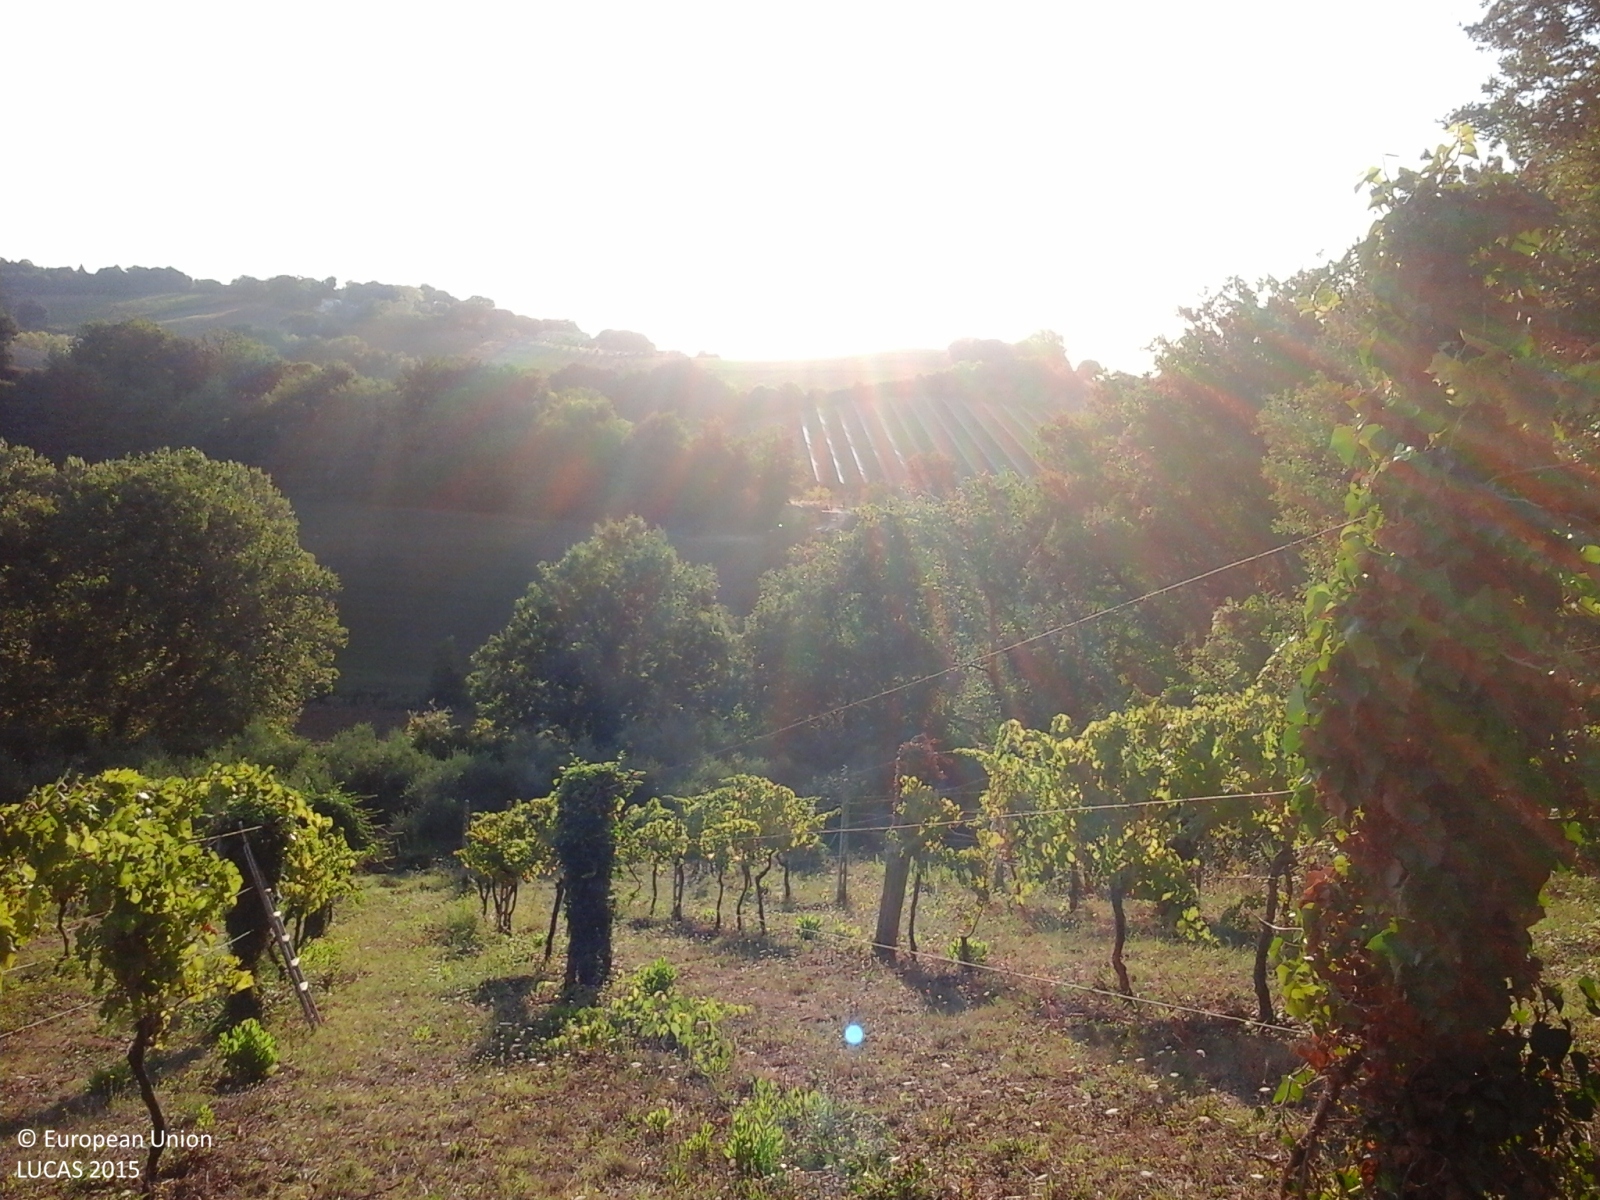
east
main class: Cropland
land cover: Vineyards
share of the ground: 50 - 75 %
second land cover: Grassland without tree/shrub cover
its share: > 75 %
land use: Agriculture (excluding fallow land and kitchen gardens)
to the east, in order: Vineyards; Grassland without tree/shrub cover; Managed hedges; Olive groves; Broadleaved woodland; Durum wheat; Managed hedges; Ditches and canals; Grass margins; Durum wheat; Lines of trees; Lucerne; Broadleaved woodland; Paved roads, cycling and walking lanes; Broadleaved woodland
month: September
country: IT
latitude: 43.8396
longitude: 12.9408
